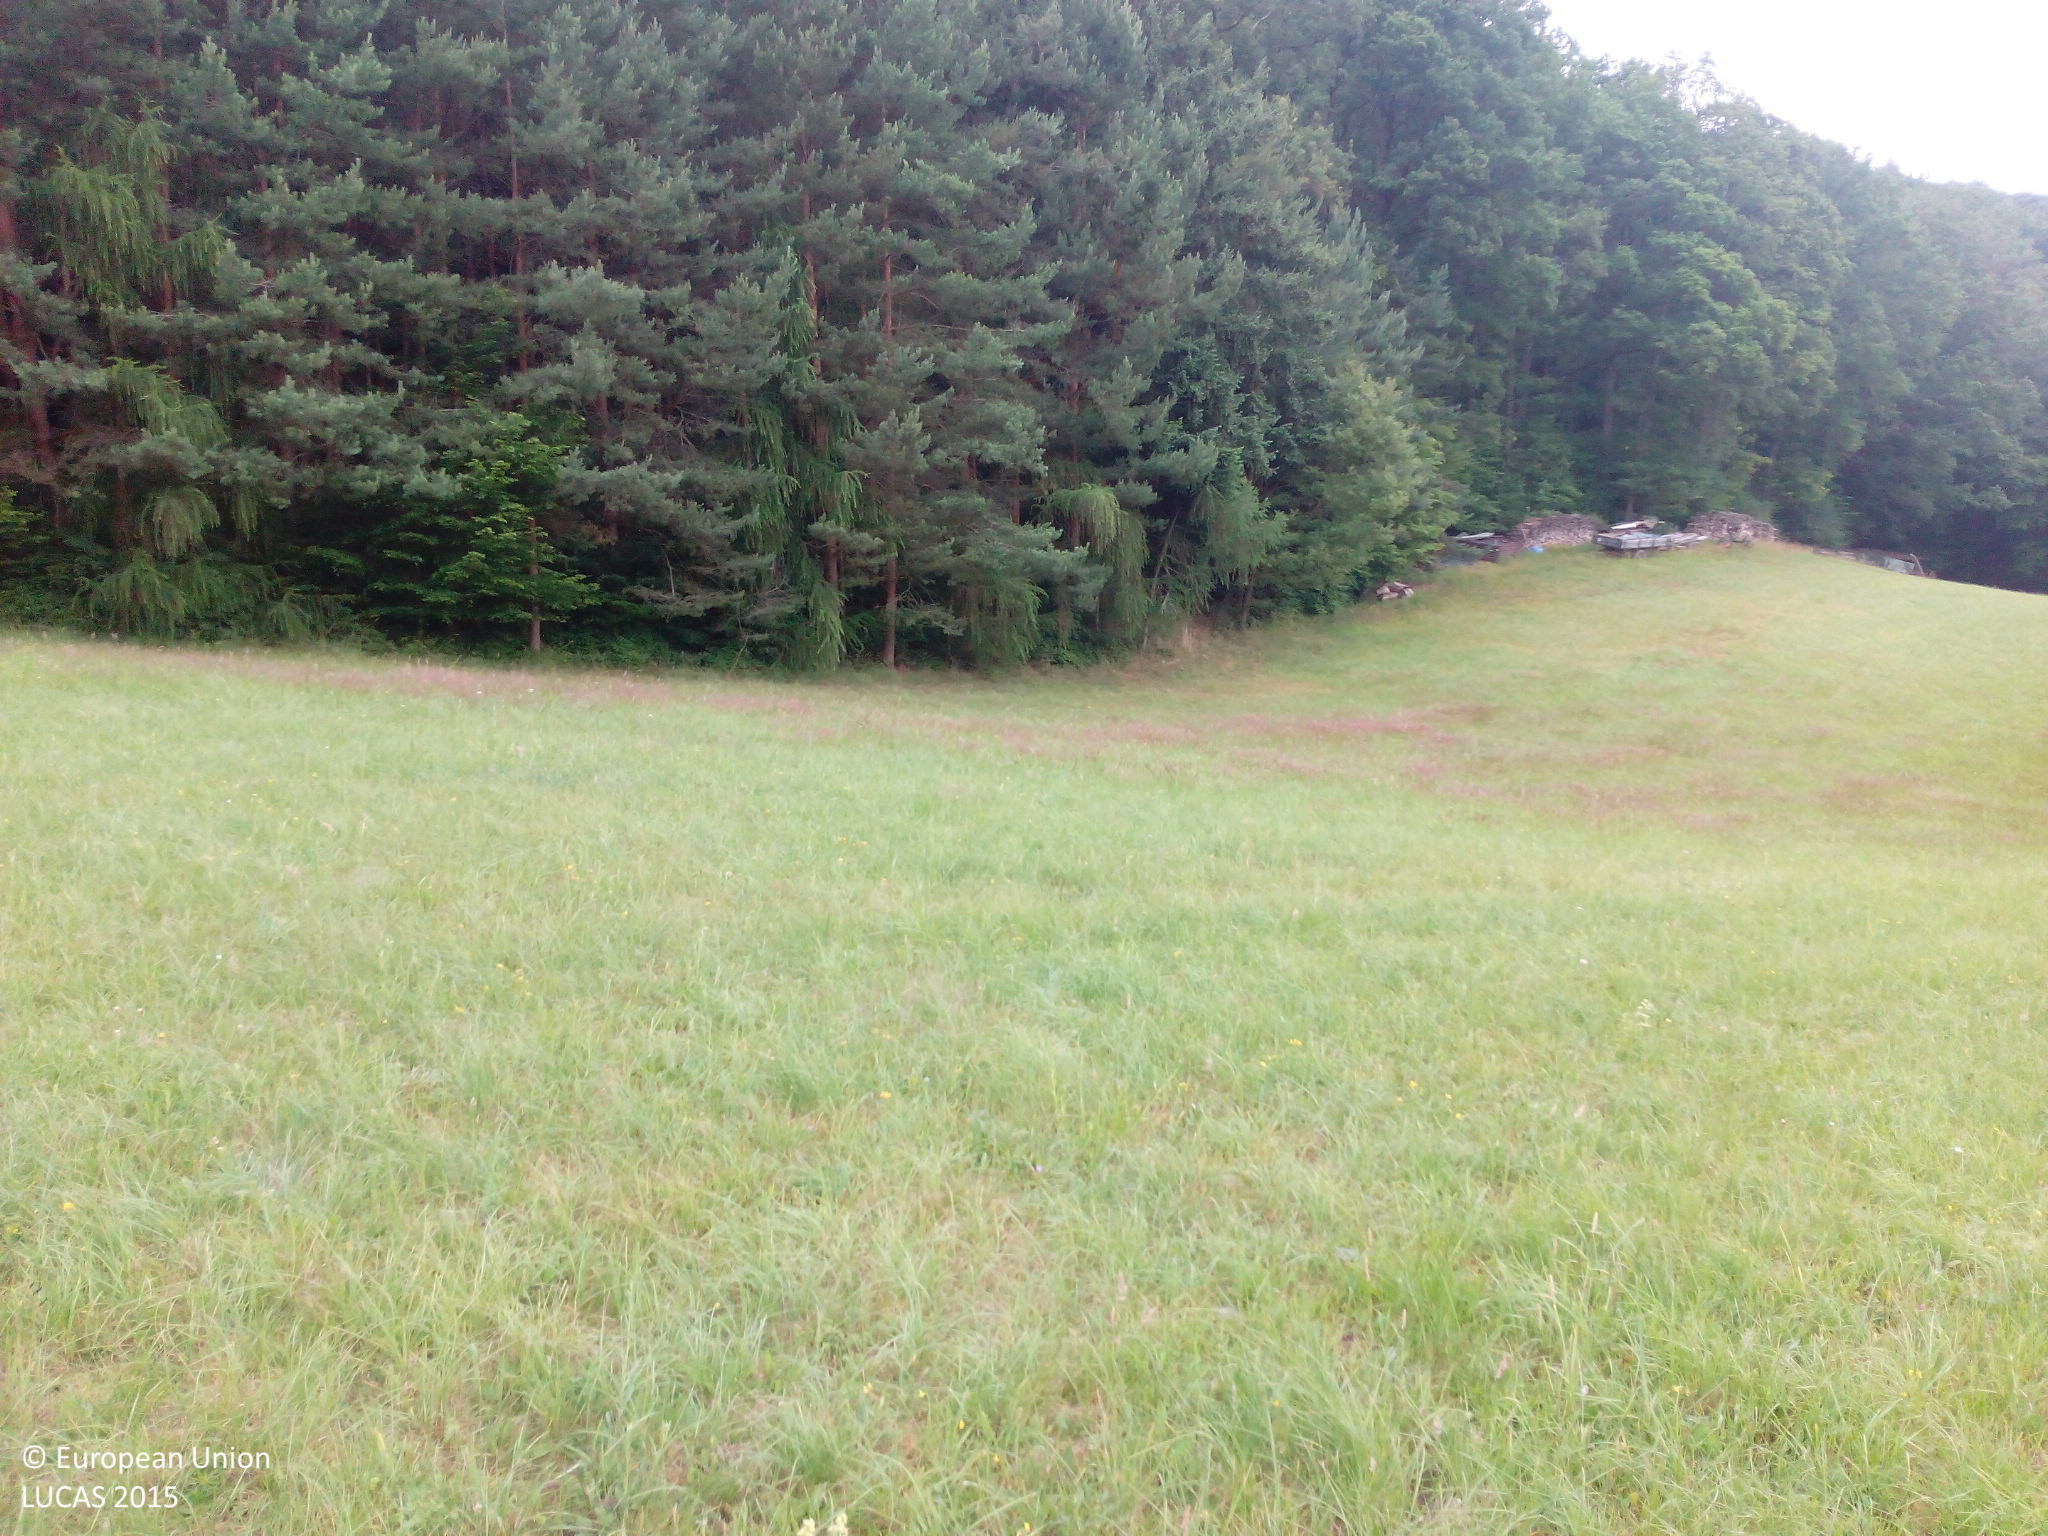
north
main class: Grassland
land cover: Grassland without tree/shrub cover
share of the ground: > 75 %
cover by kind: herbaceous plants 100 %
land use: Agriculture (excluding fallow land and kitchen gardens)
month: June
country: DE
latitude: 49.9667
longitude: 10.6272
